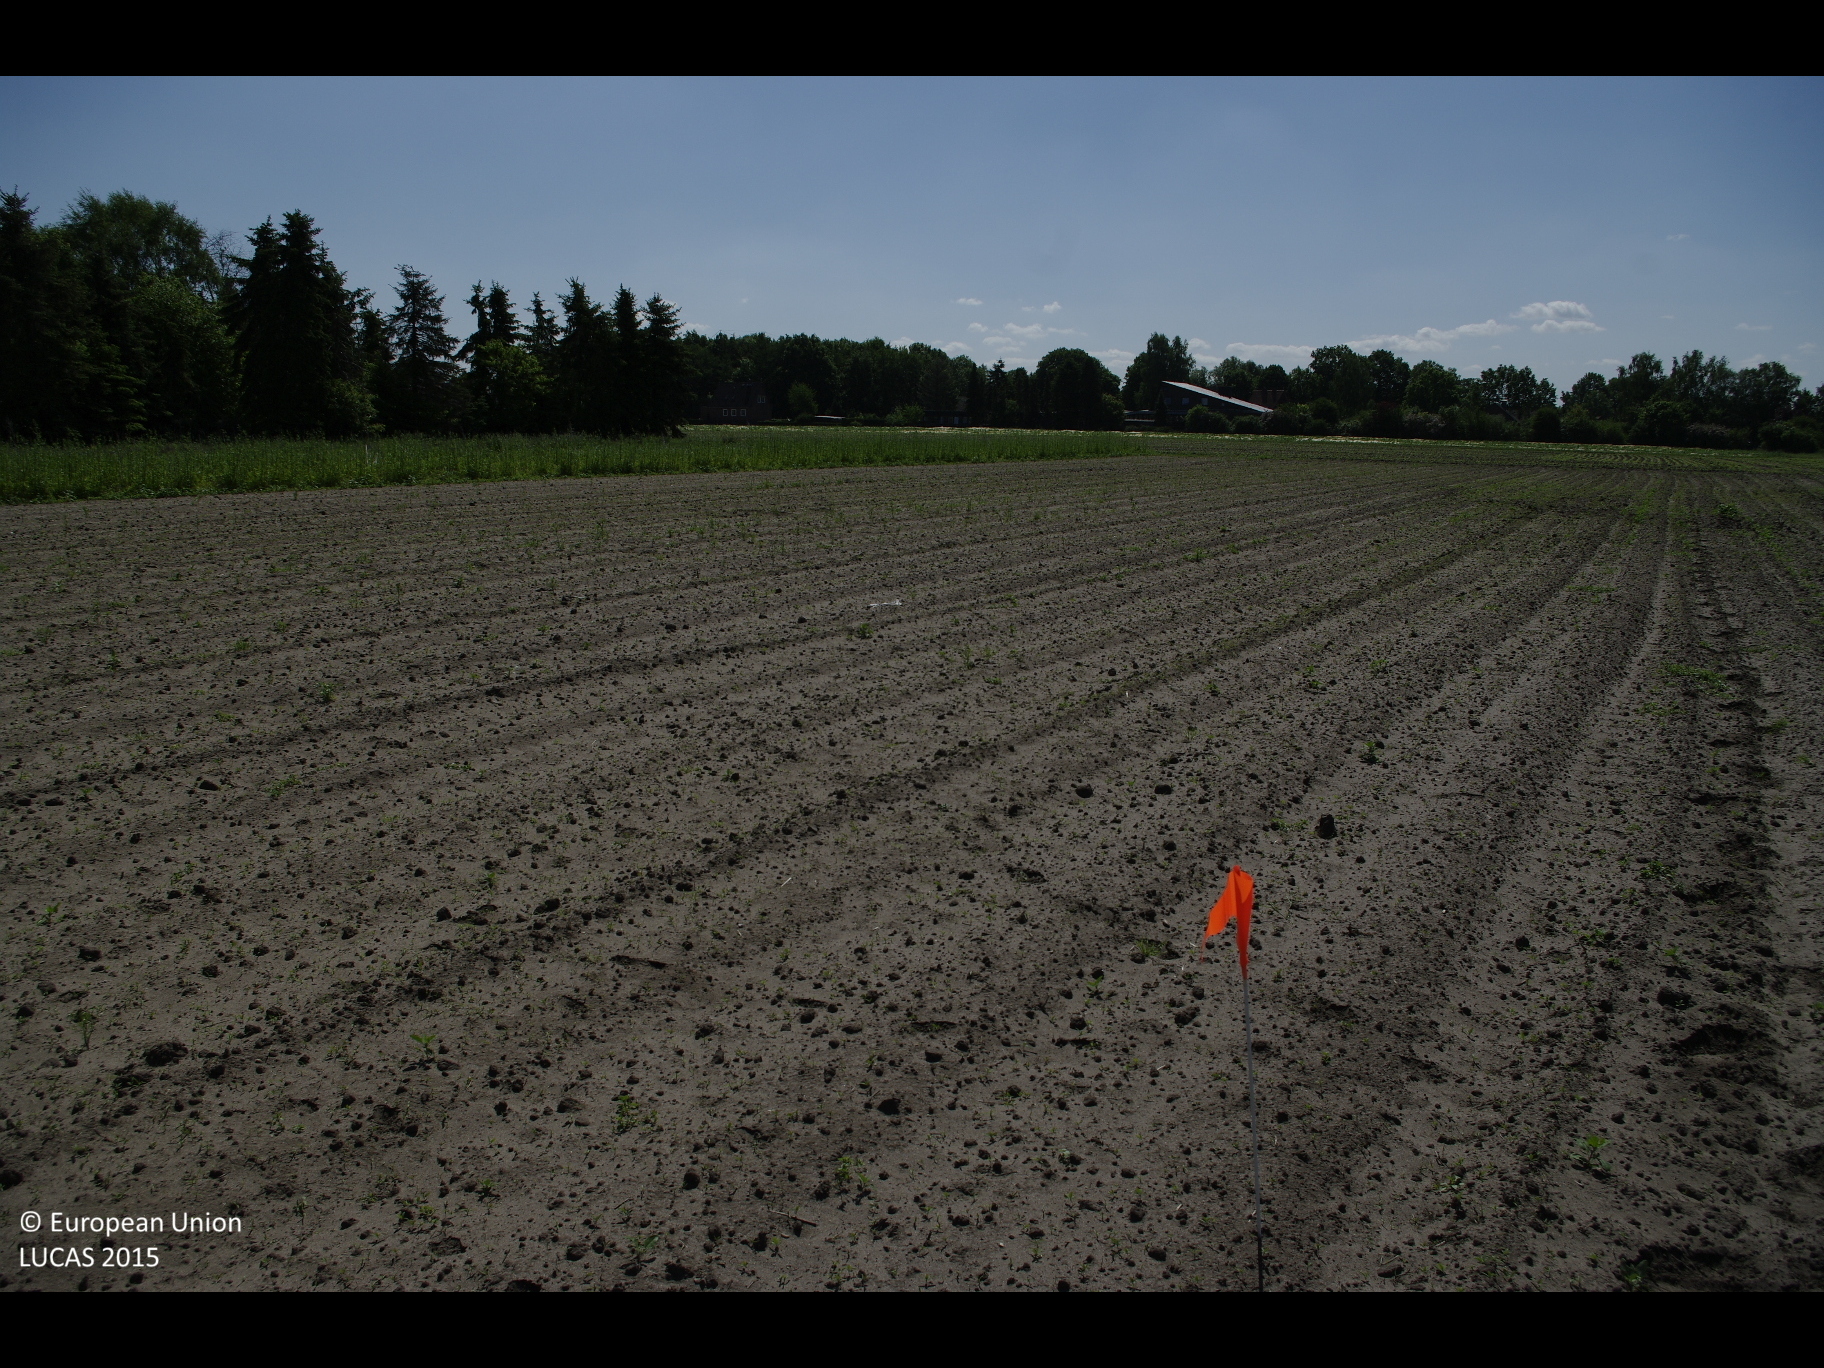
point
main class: Cropland
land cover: Maize
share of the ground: < 10 %
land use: Agriculture (excluding fallow land and kitchen gardens)
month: June
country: DE
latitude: 53.3294
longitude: 10.3752
